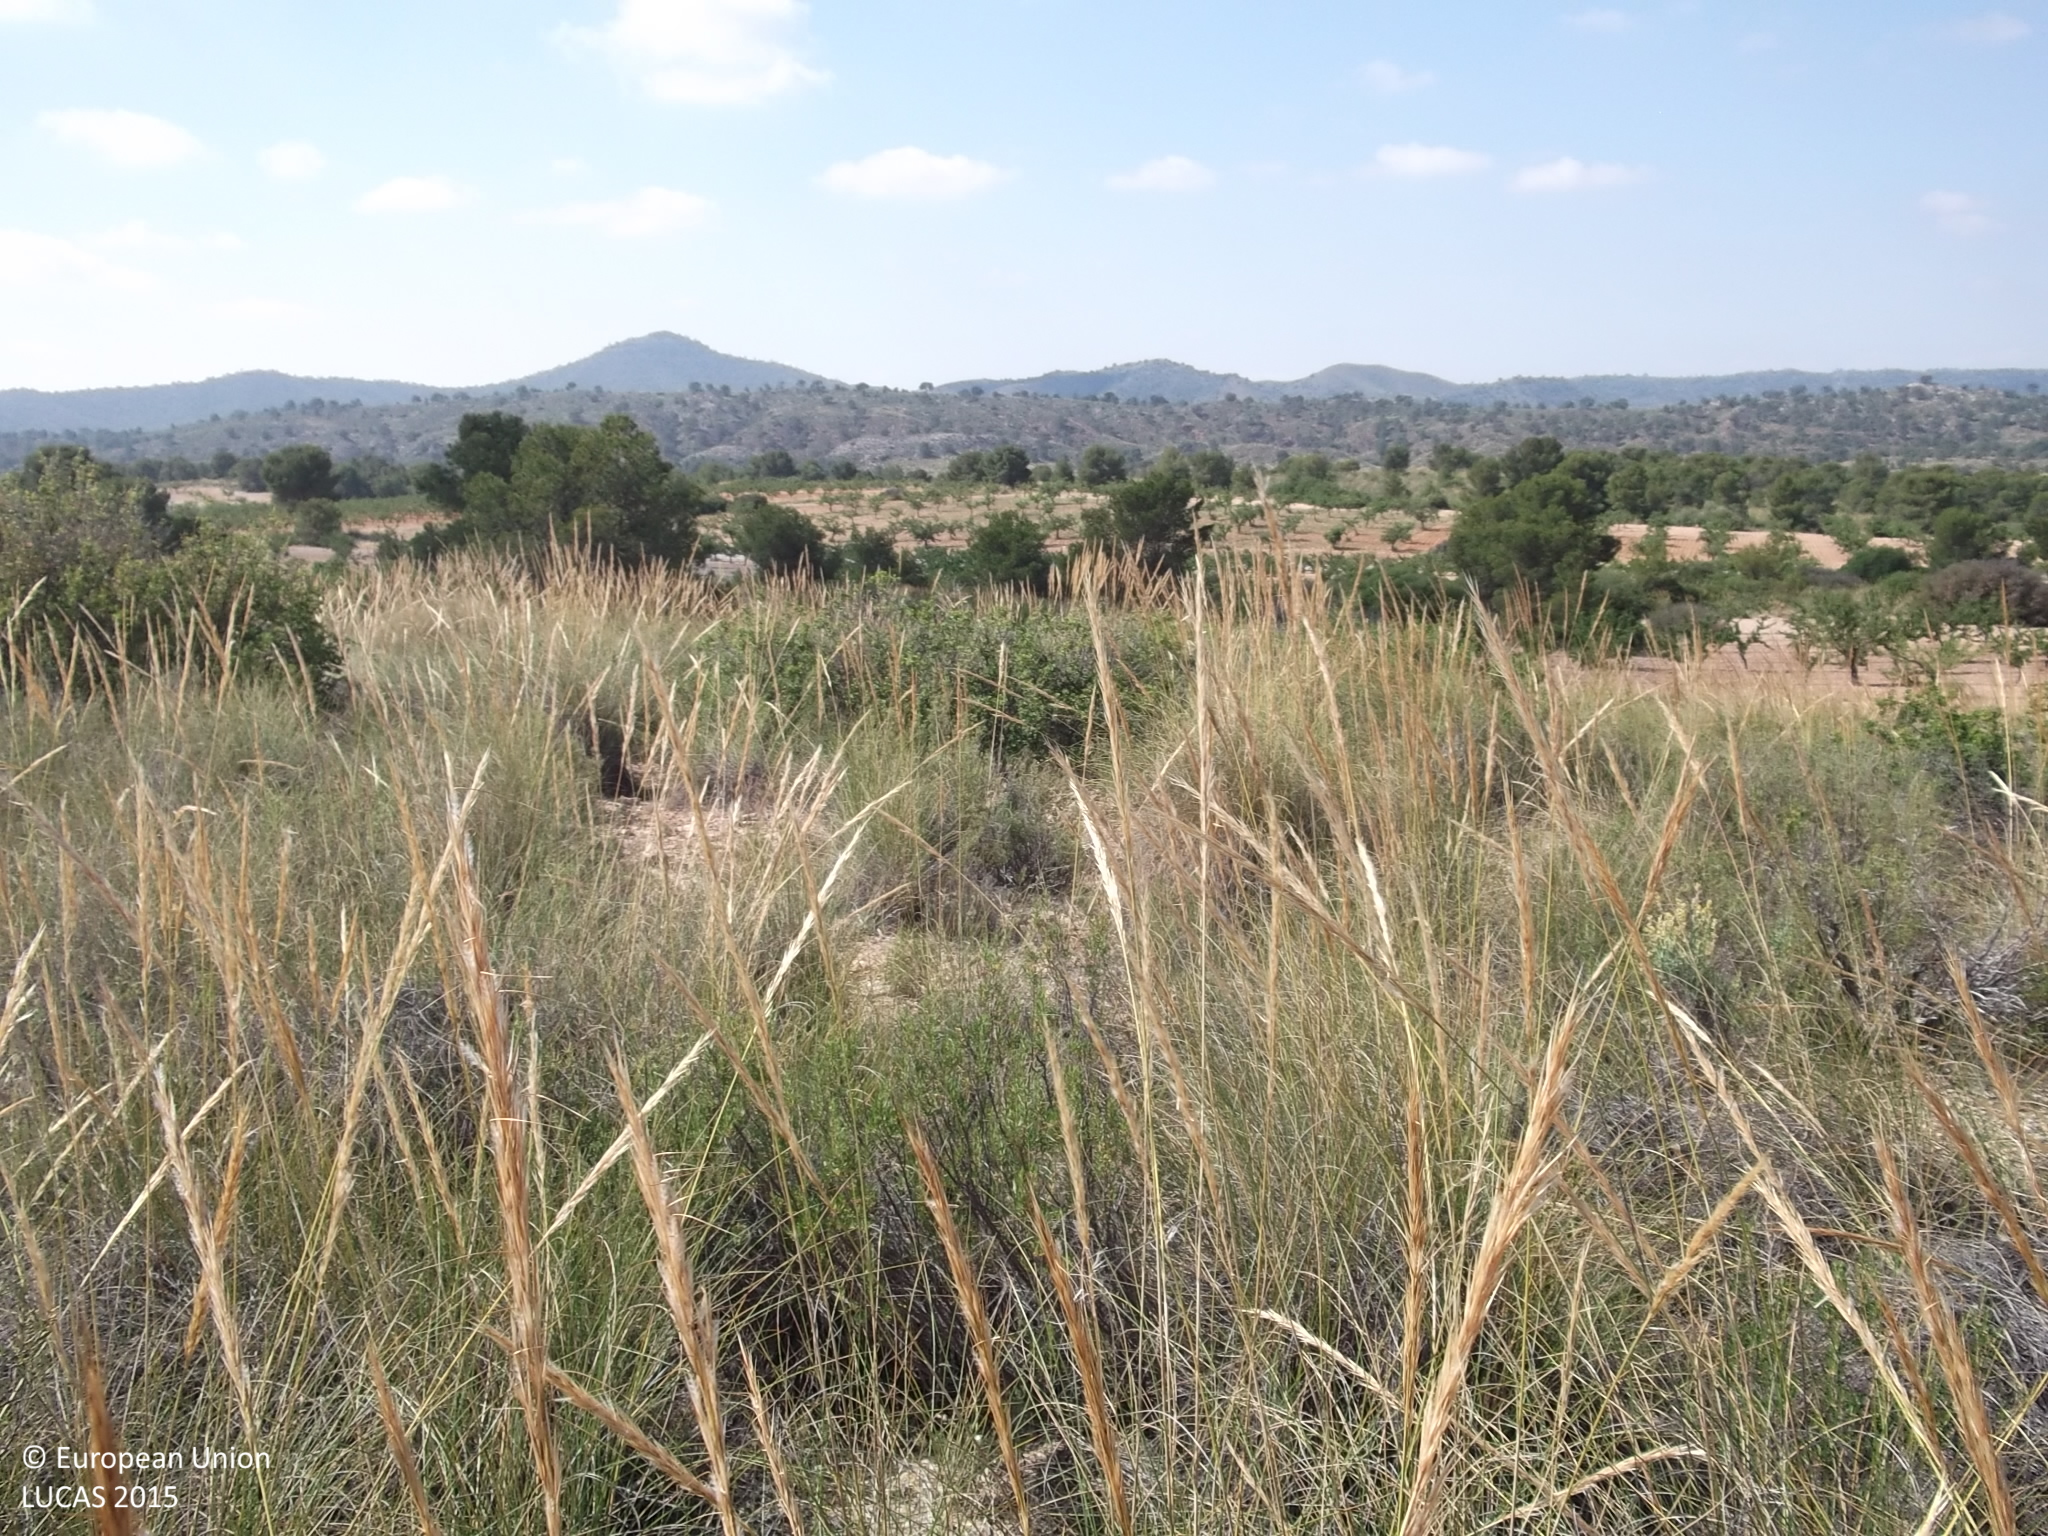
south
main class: Shrubland
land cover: Shrubland without tree cover
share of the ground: 50 - 75 %
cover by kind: shrubs 50 %, herbaceous plants 30 %, consolidated bare surface 20 %
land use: Semi-natural and natural areas not in use
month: May
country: ES
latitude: 38.4756
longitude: -1.4885
